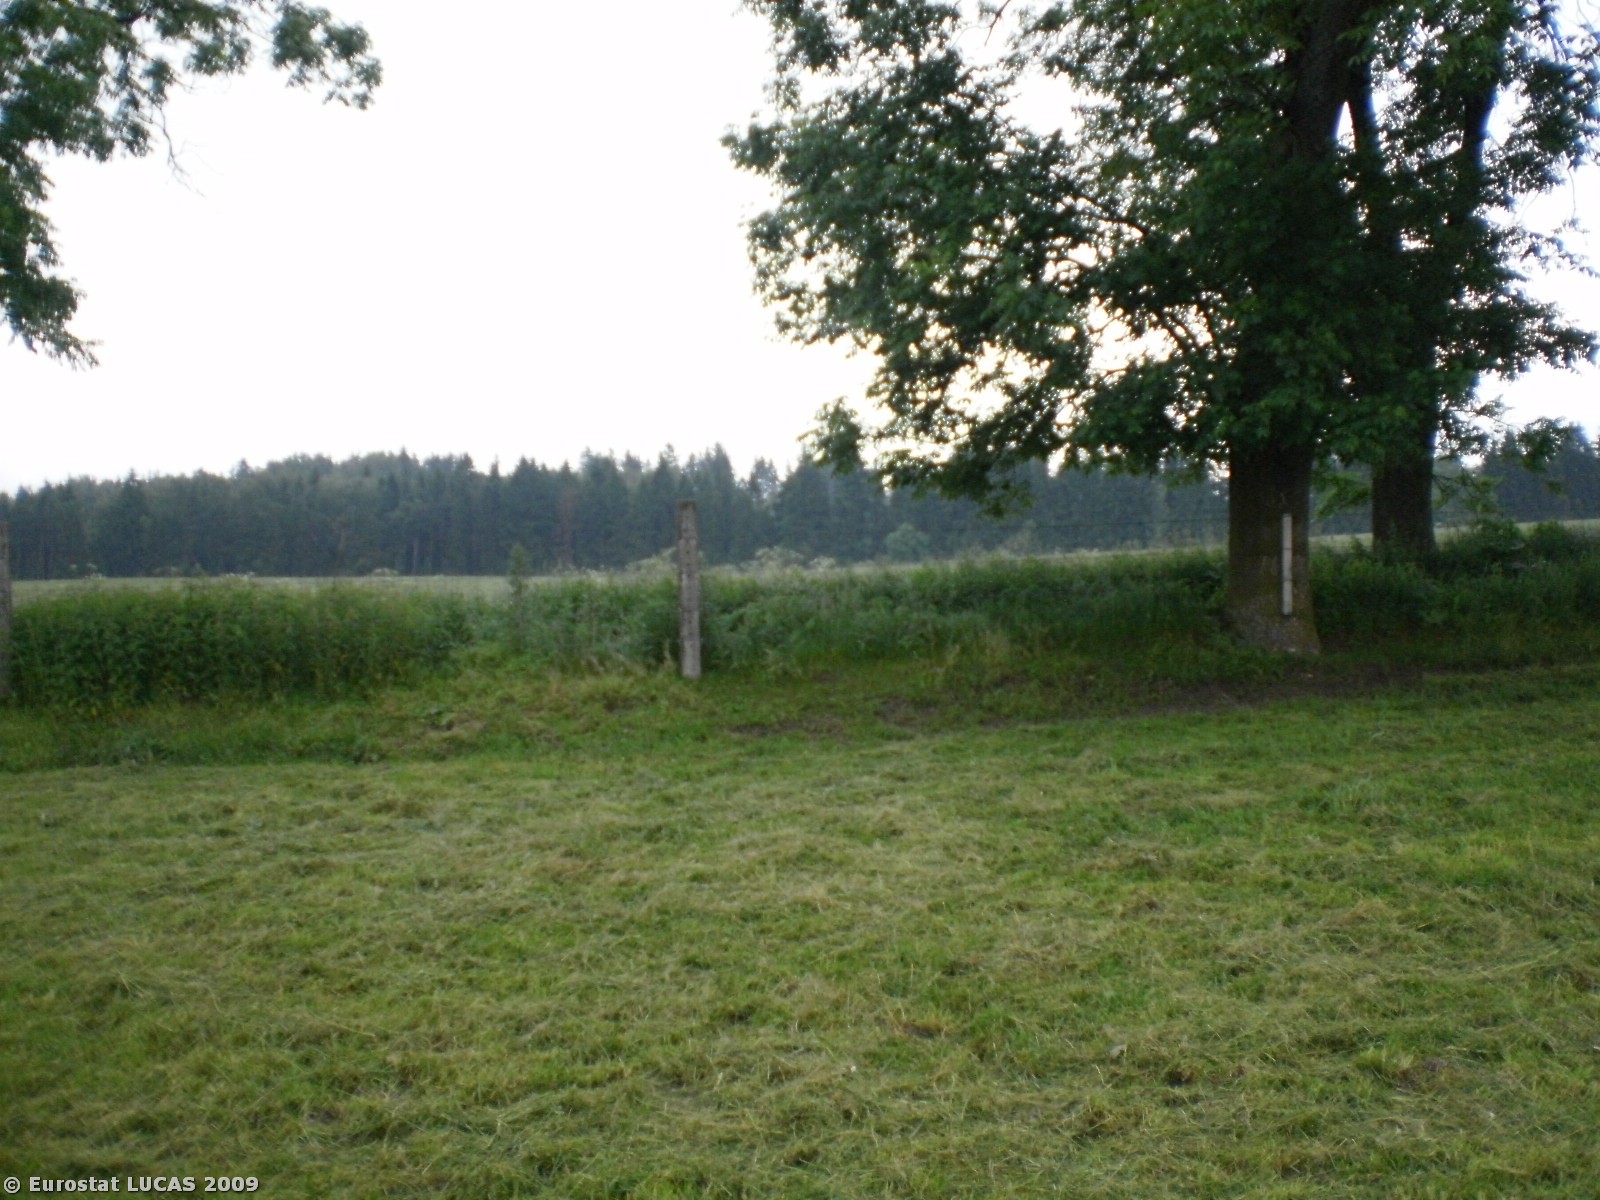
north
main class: Grassland
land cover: Grassland without tree/shrub cover
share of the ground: > 75 %
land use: Agriculture (excluding fallow land and kitchen gardens)
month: June
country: PL
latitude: 53.5984
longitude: 19.8366
